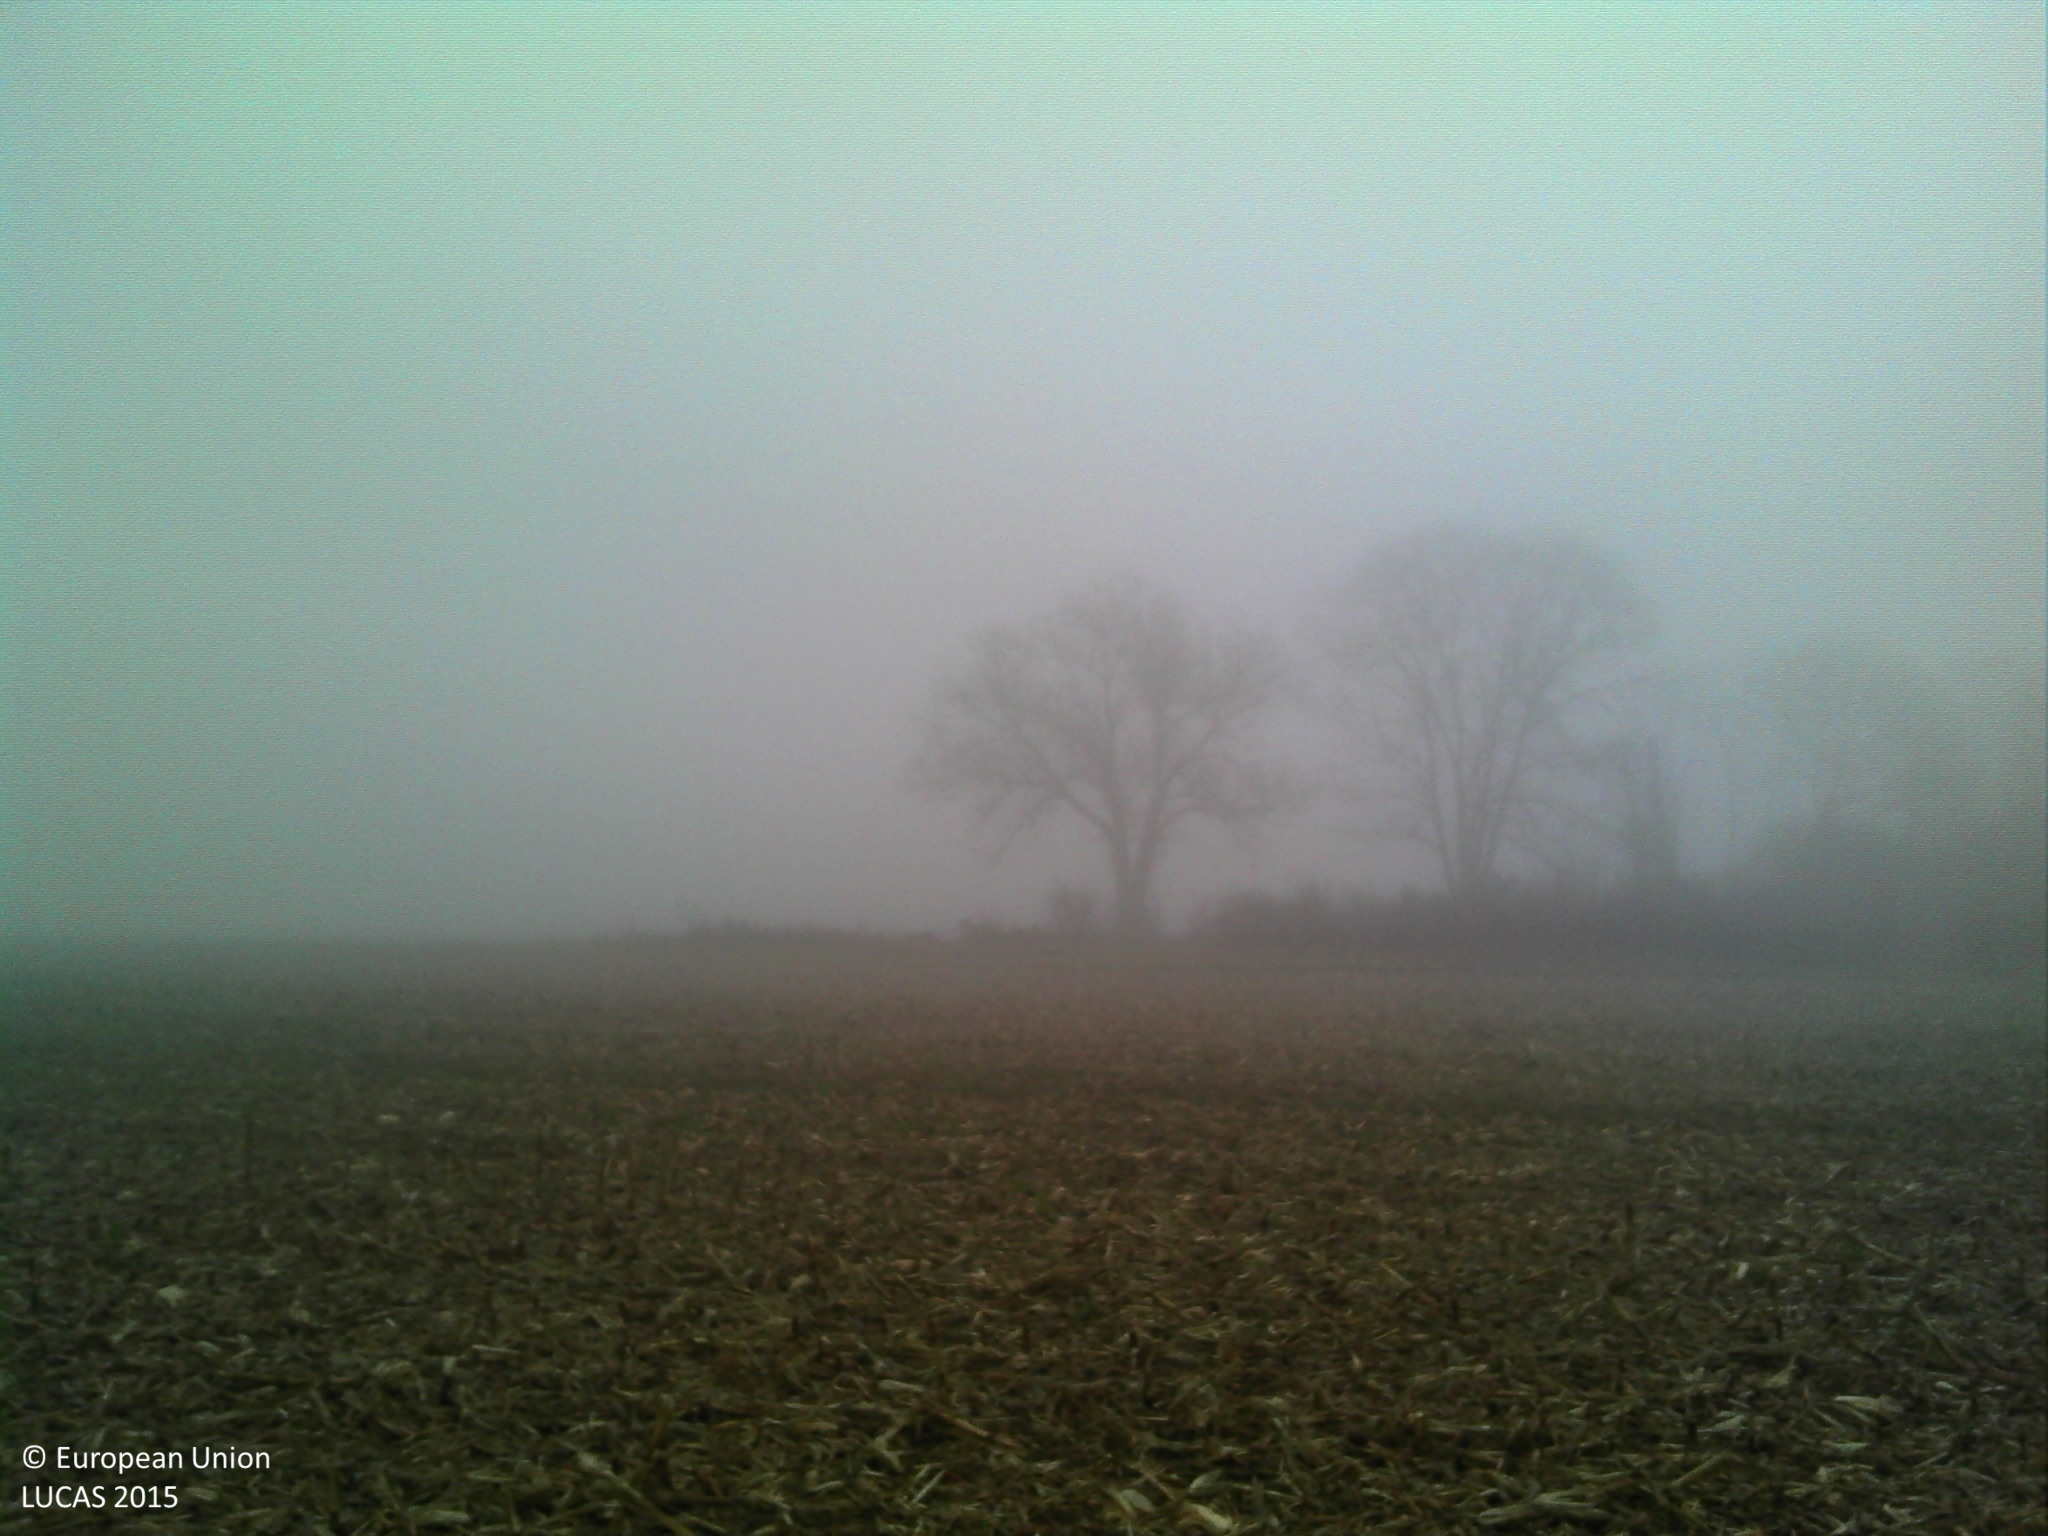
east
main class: Cropland
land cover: Maize
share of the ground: > 75 %
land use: Agriculture (excluding fallow land and kitchen gardens)
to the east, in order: Maize; Tracks; Ditches and canals; Spontaneously vegetated surfaces; Tracks; Lines of trees; Grassland without tree/shrub cover; Maize; Electric lines; Maize
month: December
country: FR
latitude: 46.0140
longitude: 5.3151
